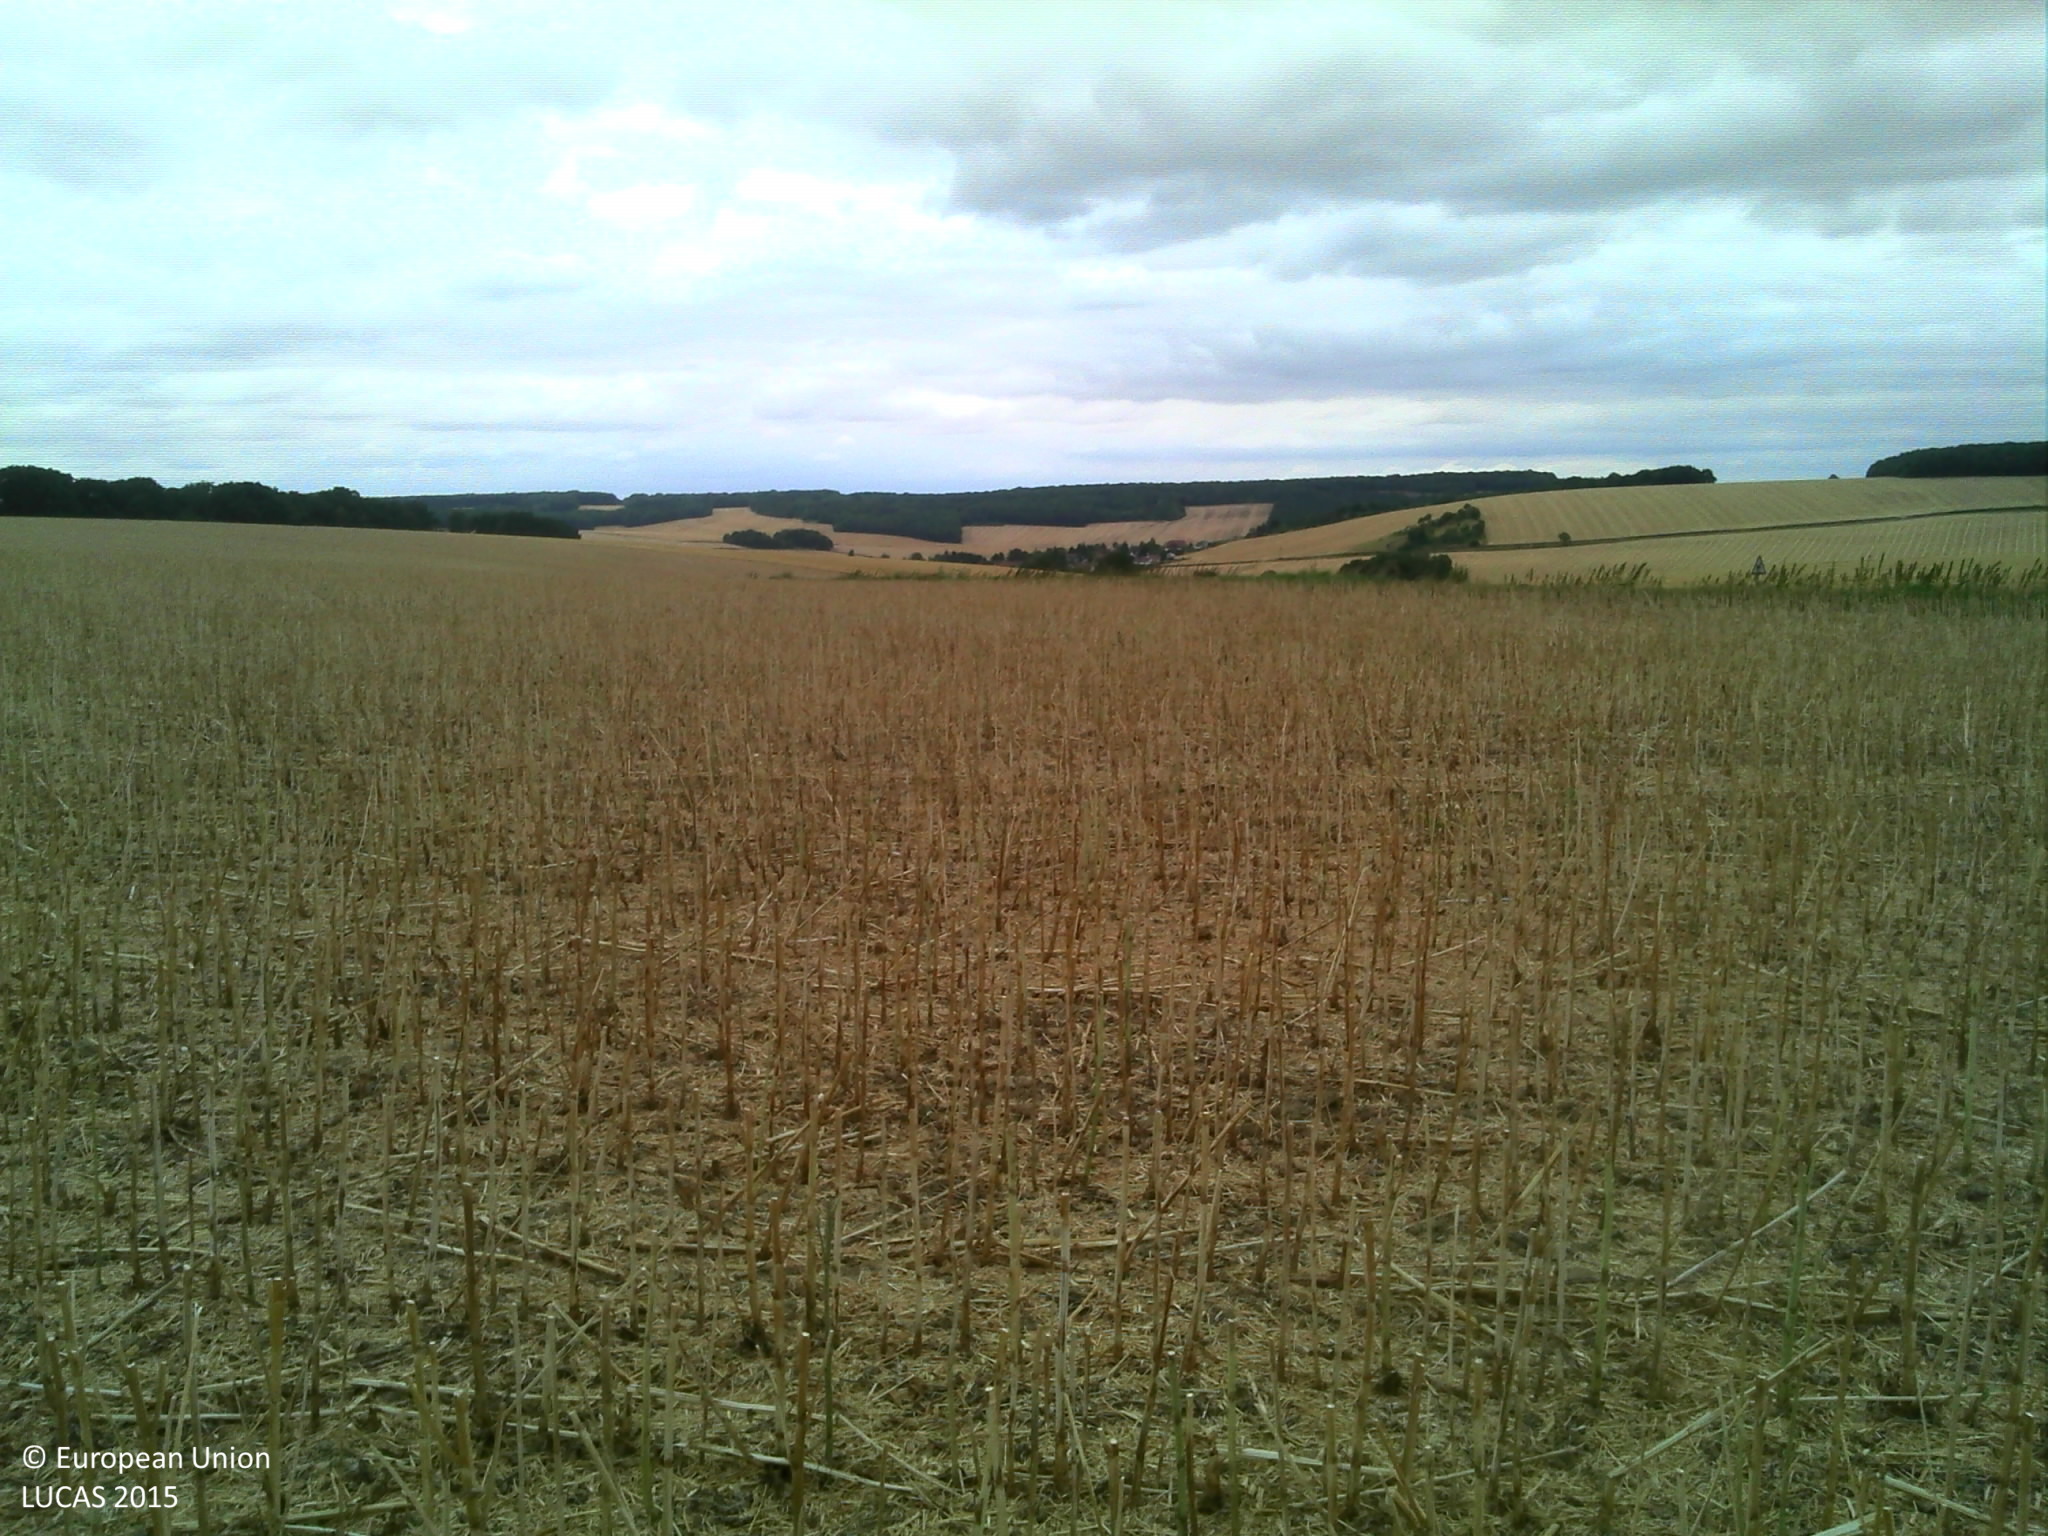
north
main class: Cropland
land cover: Rape and turnip rape
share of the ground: > 75 %
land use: Agriculture (excluding fallow land and kitchen gardens)
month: July
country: FR
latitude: 48.2055
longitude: 3.3872
